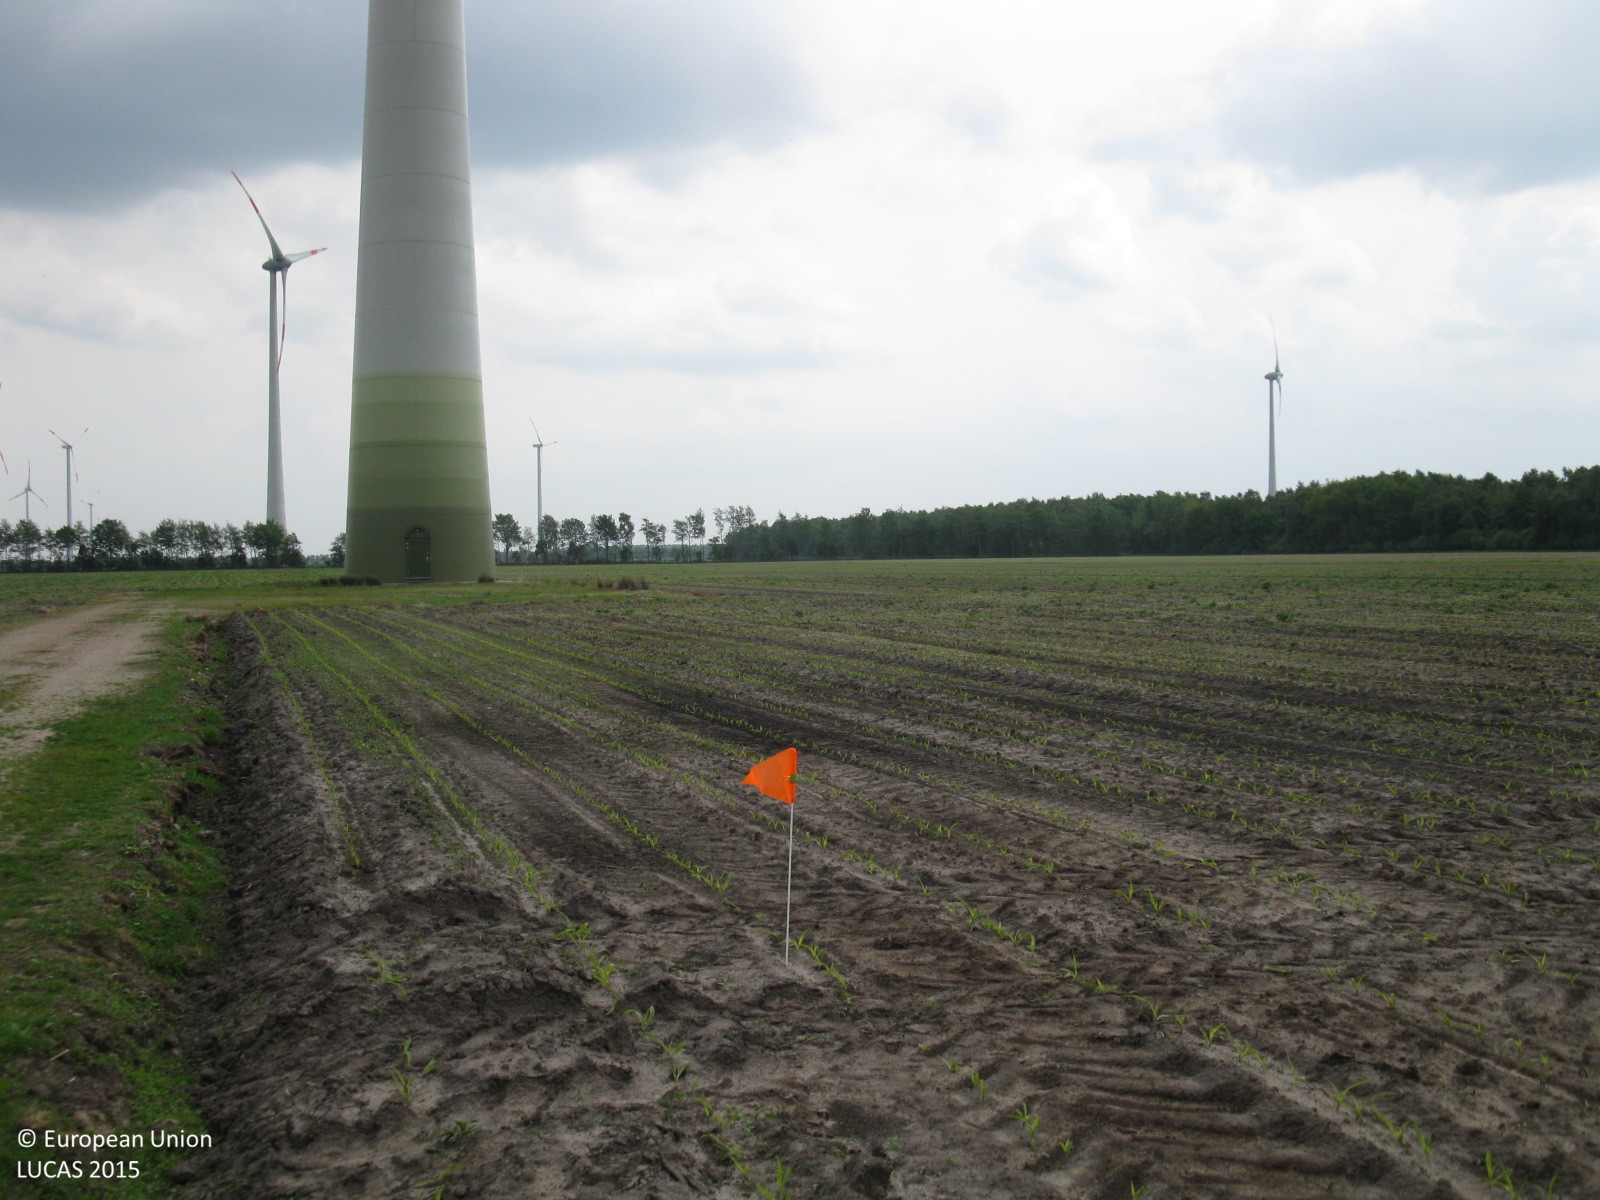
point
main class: Cropland
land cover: Maize
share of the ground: < 10 %
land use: Agriculture (excluding fallow land and kitchen gardens)
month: May
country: DE
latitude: 52.9789
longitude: 7.4240
